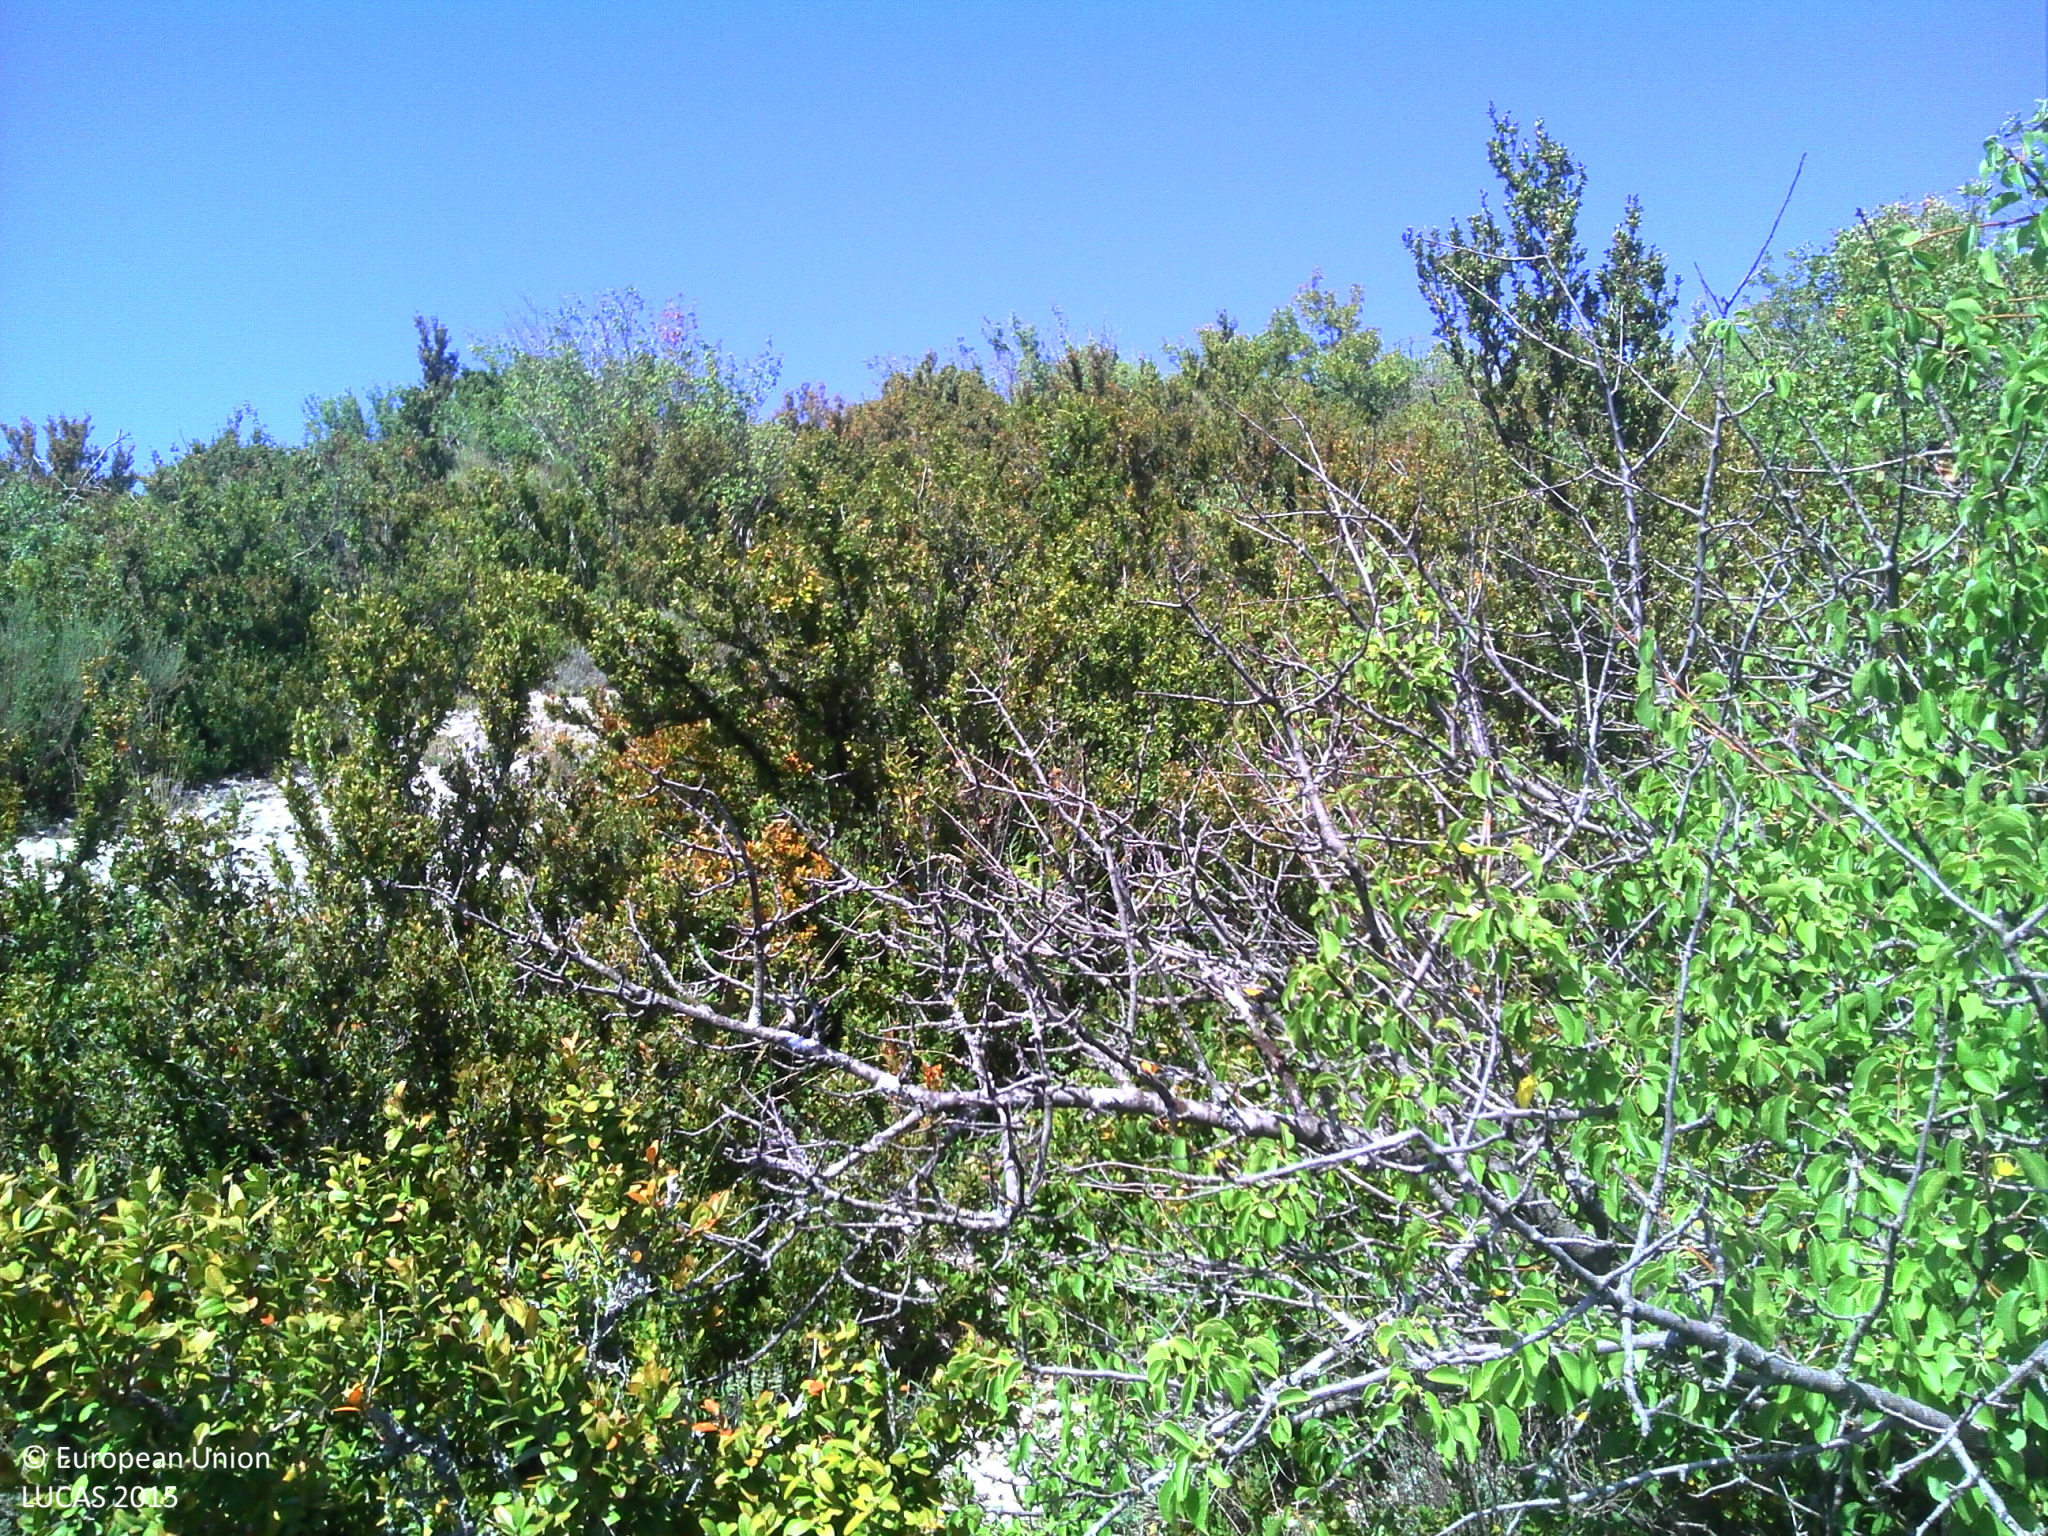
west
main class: Shrubland
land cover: Shrubland without tree cover
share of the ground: > 75 %
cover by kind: shrubs 90 %, unconsolidated bare surface 10 %
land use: Semi-natural and natural areas not in use
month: September
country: FR
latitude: 44.4594
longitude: 5.2689
